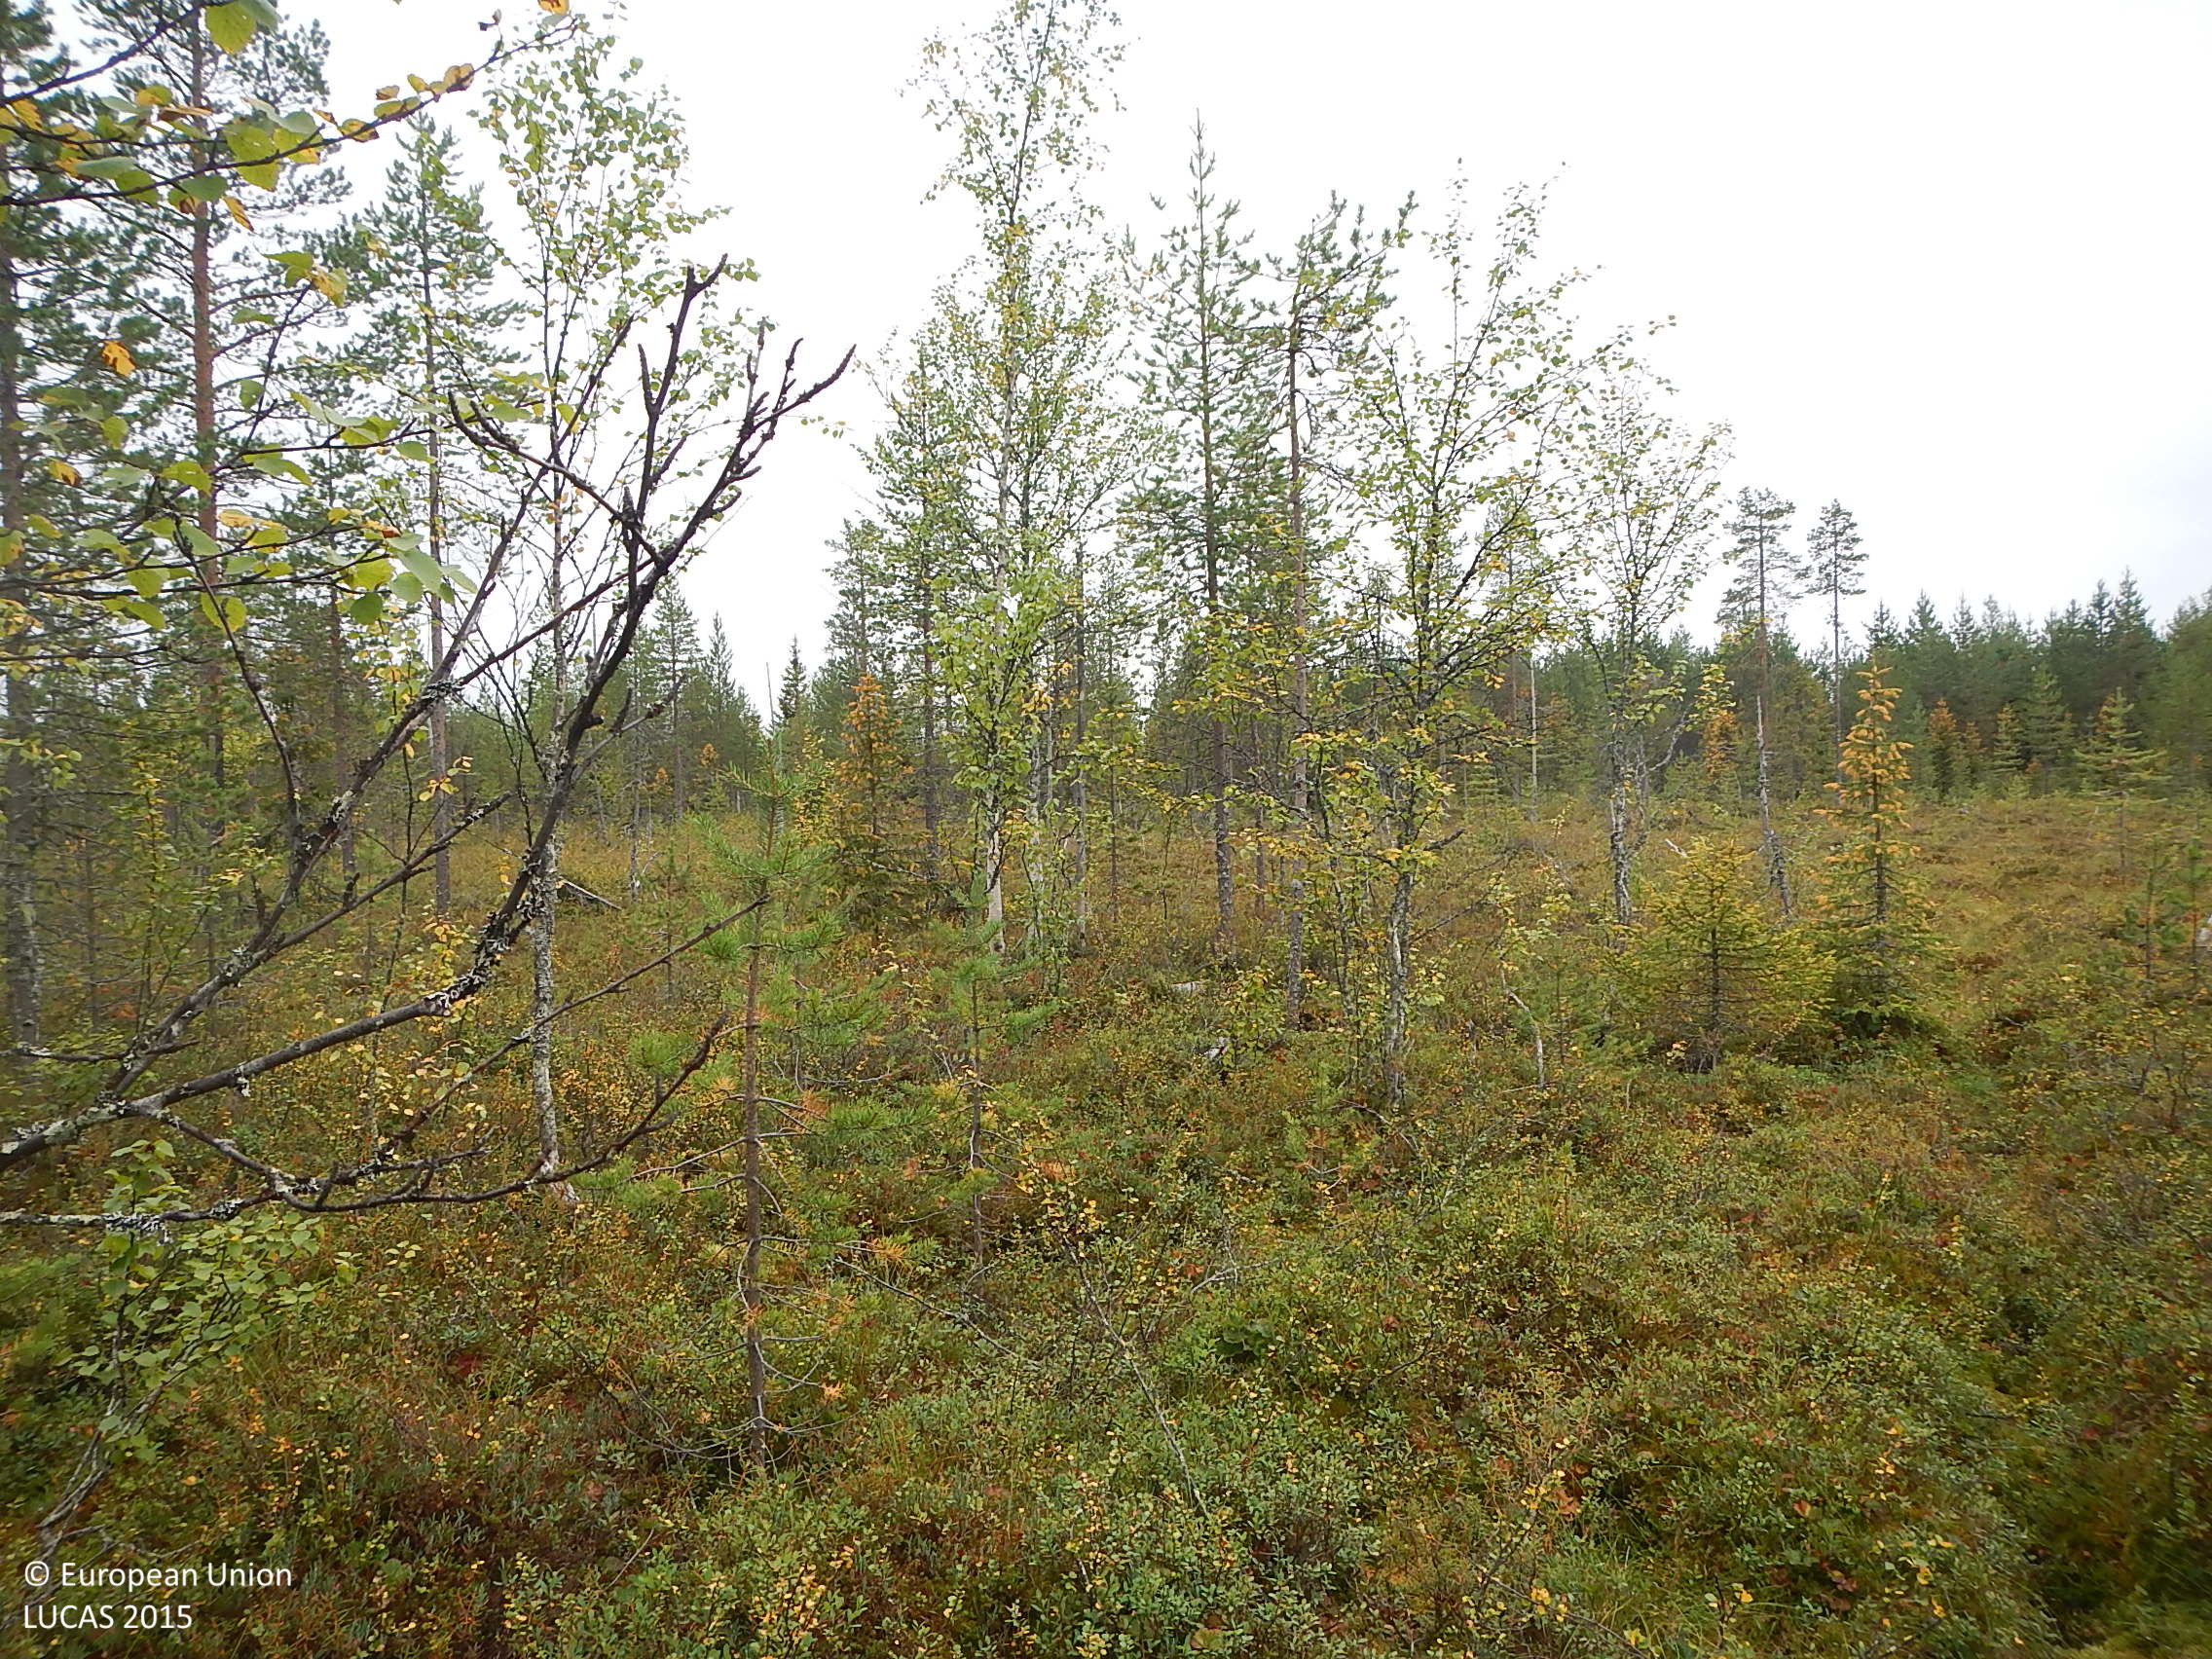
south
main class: Woodland
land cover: Pine dominated mixed woodland
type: boreal forest
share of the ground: 50 - 75 %
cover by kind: shrubs 40 %, coniferous forest trees 25 %, broadleaved forest trees 25 %, lichens and mosses 10 %
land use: Semi-natural and natural areas not in use
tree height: < 5 m
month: August
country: FI
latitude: 66.1547
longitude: 27.4761
